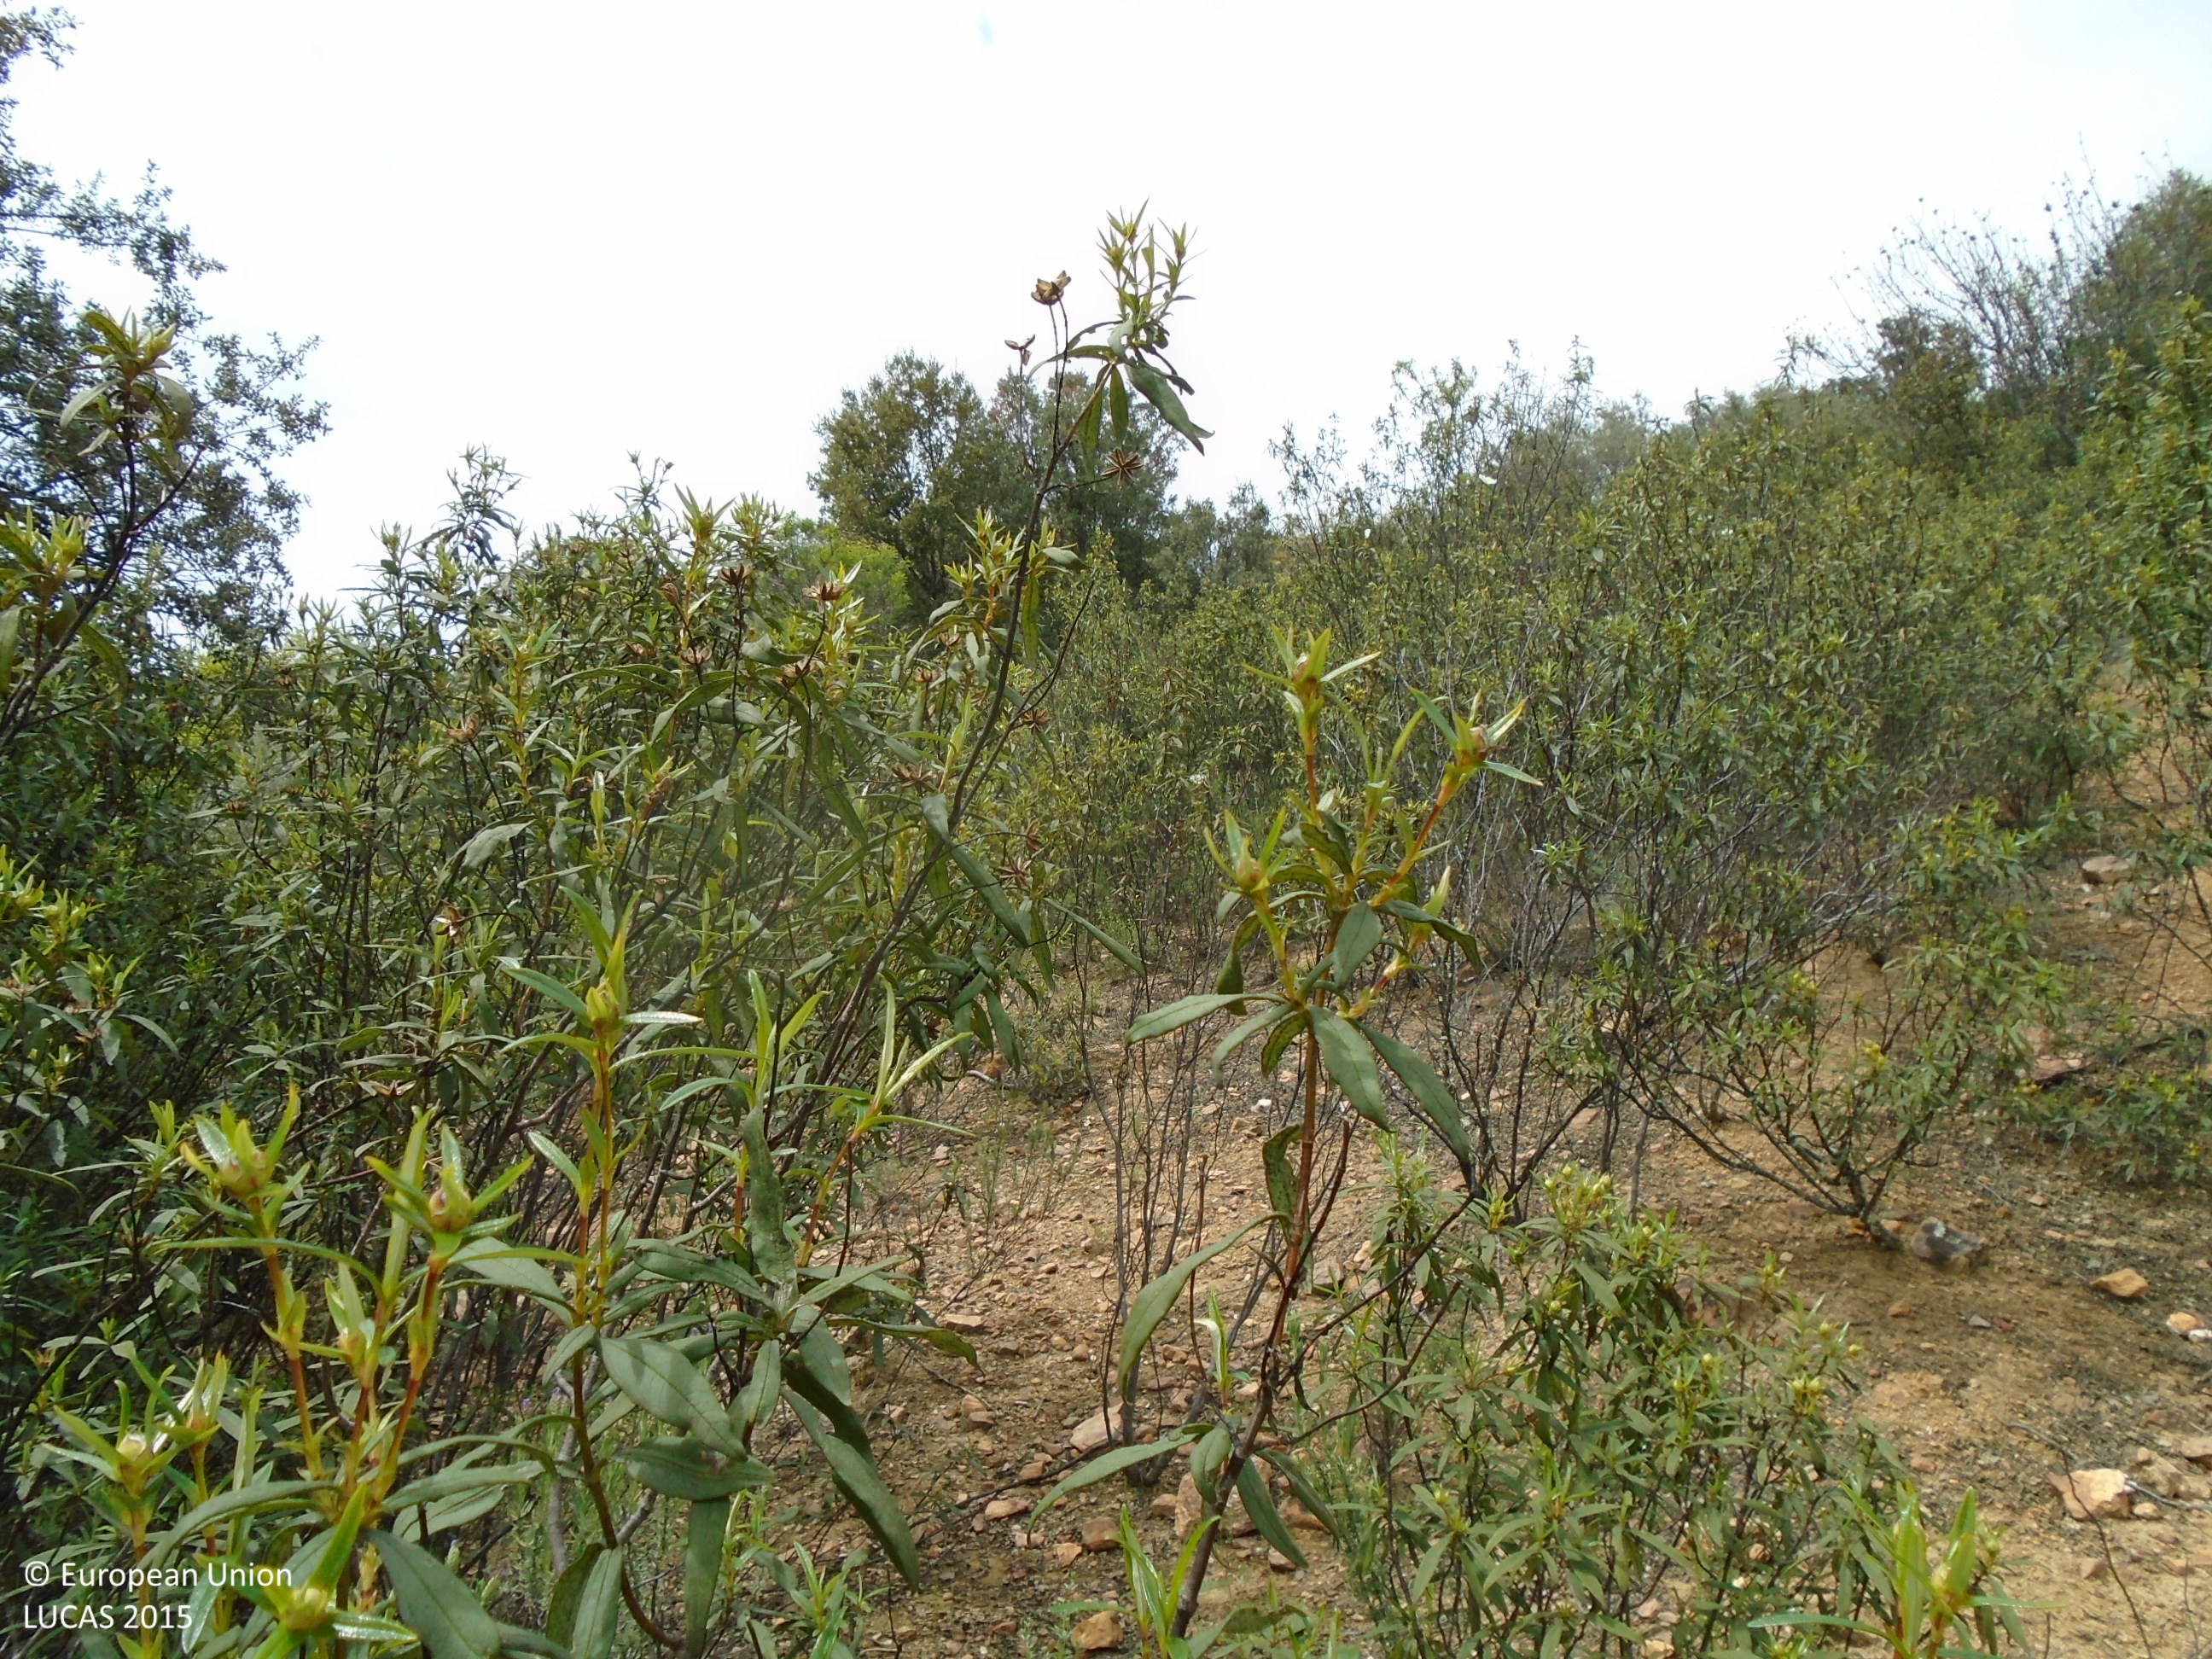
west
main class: Woodland
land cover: Broadleaved woodland
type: broadleaved evergreen forest
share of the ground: > 75 %
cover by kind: broadleaved forest trees 85 %, shrubs 10 %, consolidated bare surface 5 %
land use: Semi-natural and natural areas not in use
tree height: > 5 m
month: May
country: ES
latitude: 39.6189
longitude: -4.8959
